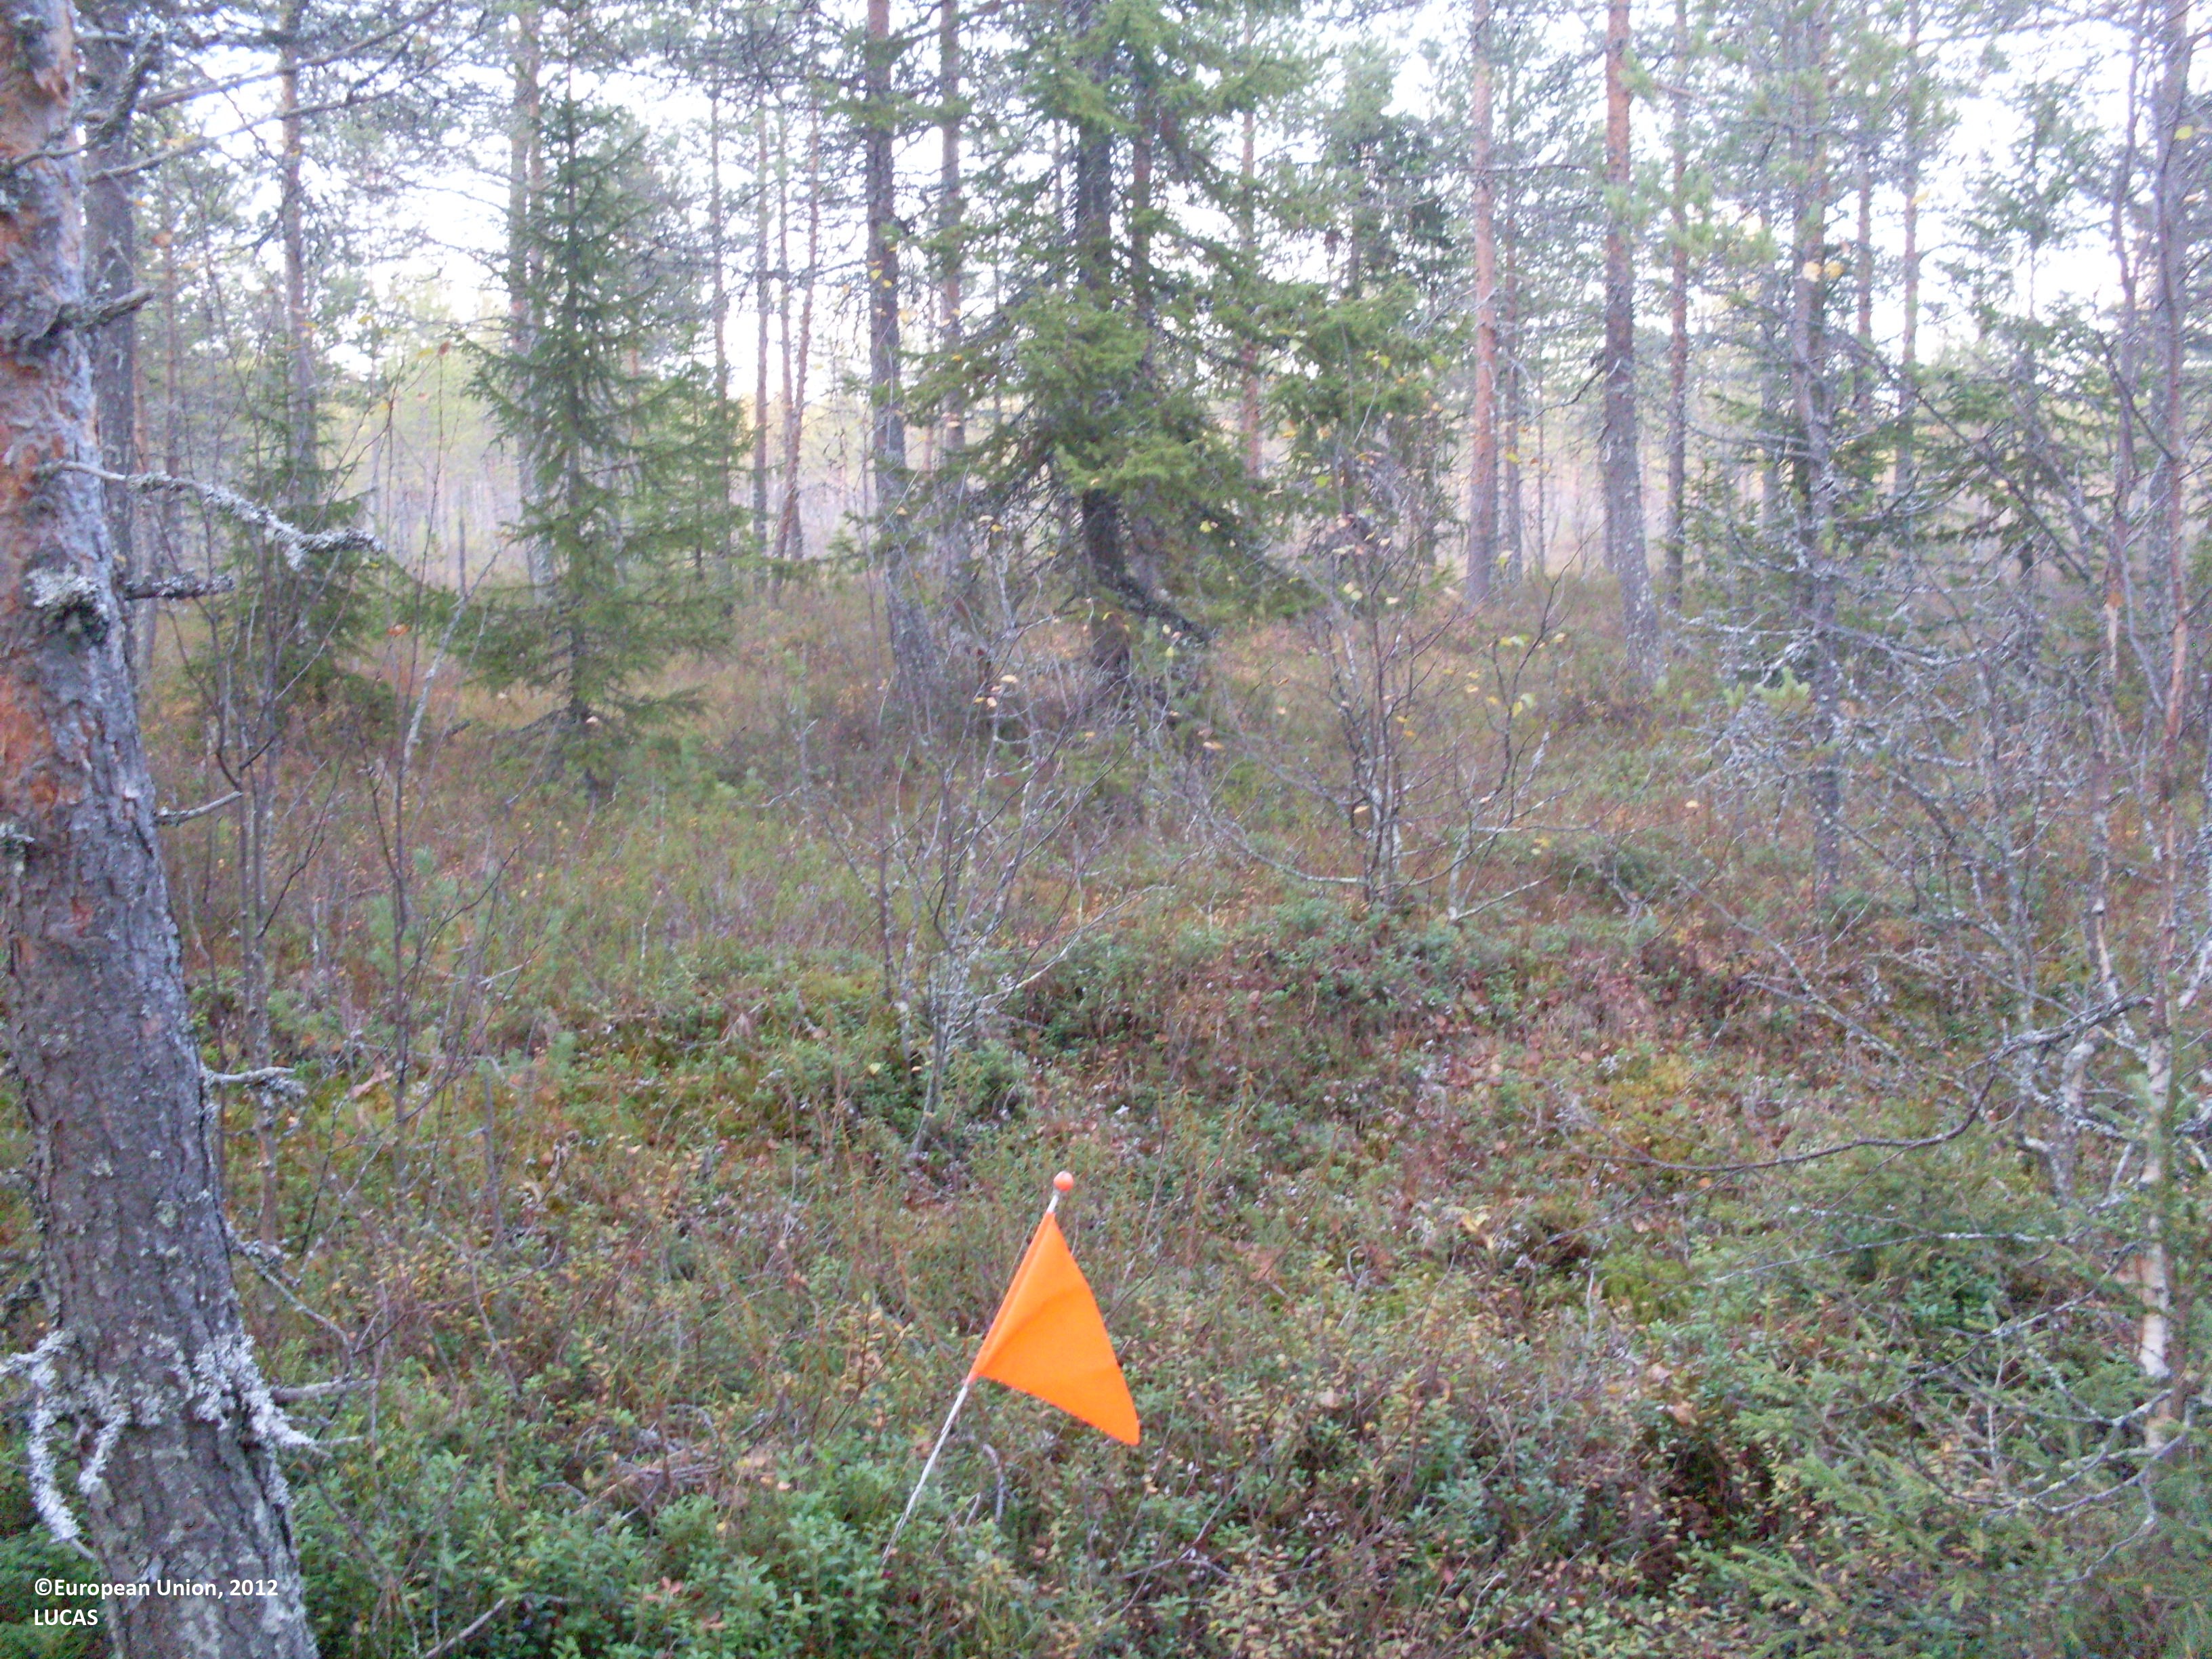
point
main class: Woodland
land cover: Pine dominated mixed woodland
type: boreal forest
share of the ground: 50 - 75 %
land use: Forestry
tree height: > 5 m
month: September
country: FI
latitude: 64.6180
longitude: 29.5979
